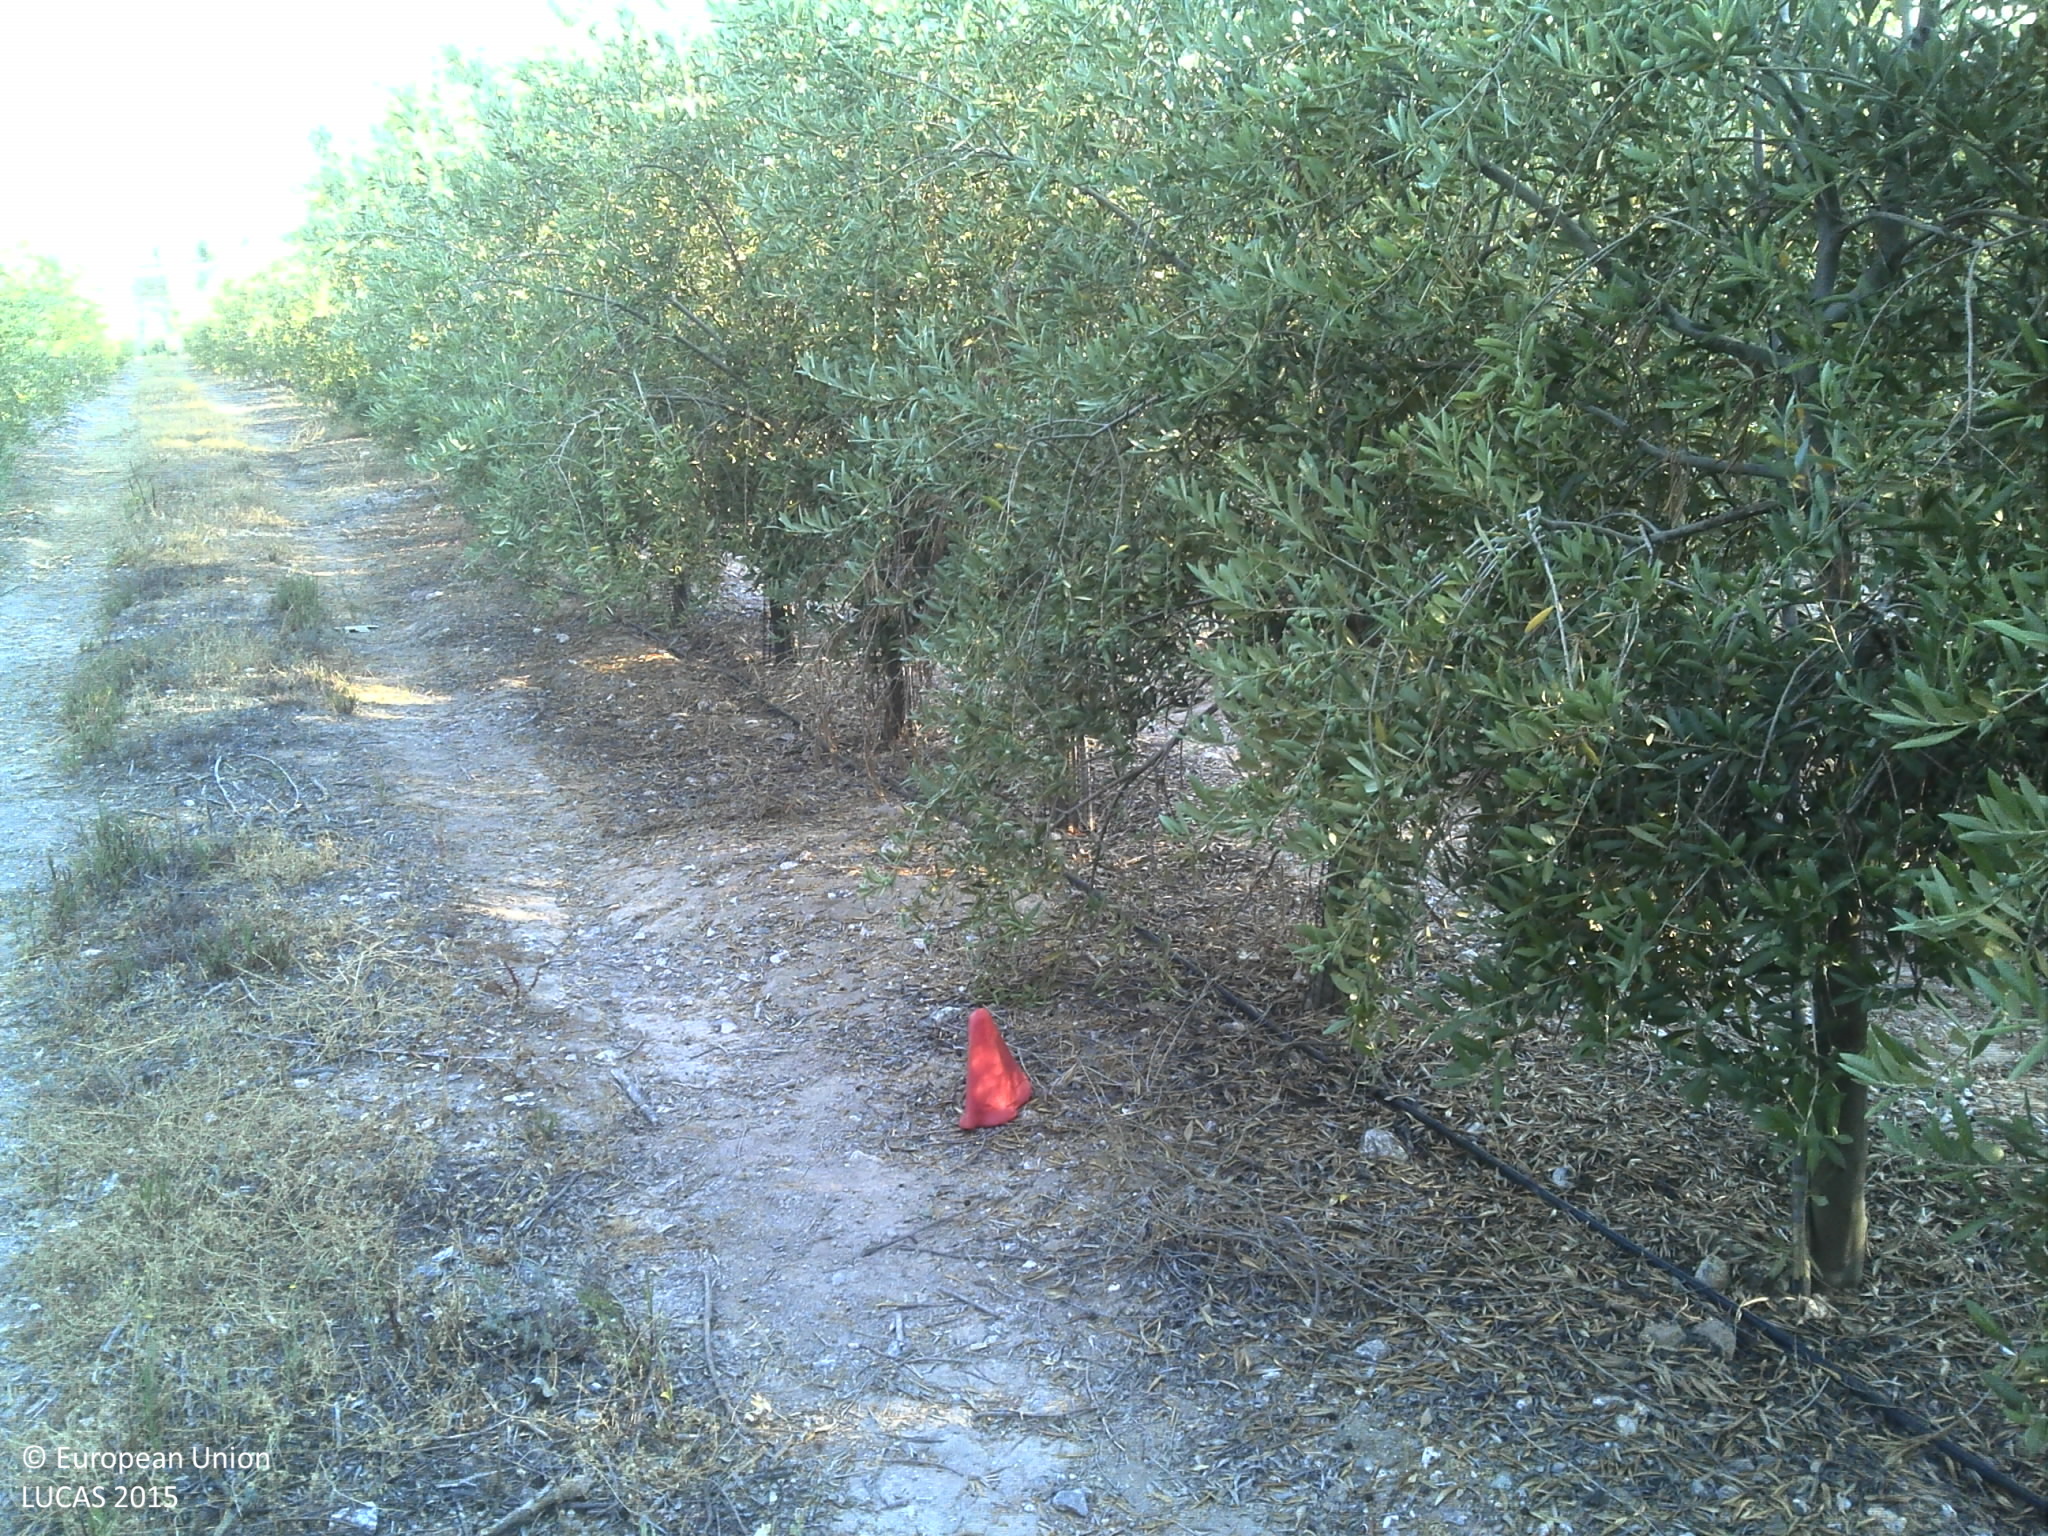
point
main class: Cropland
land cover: Olive groves
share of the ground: 50 - 75 %
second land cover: Grassland without tree/shrub cover
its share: 10 - 25 %
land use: Agriculture (excluding fallow land and kitchen gardens)
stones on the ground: < 10 %
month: June
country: PT
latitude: 38.3162
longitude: -7.3727
